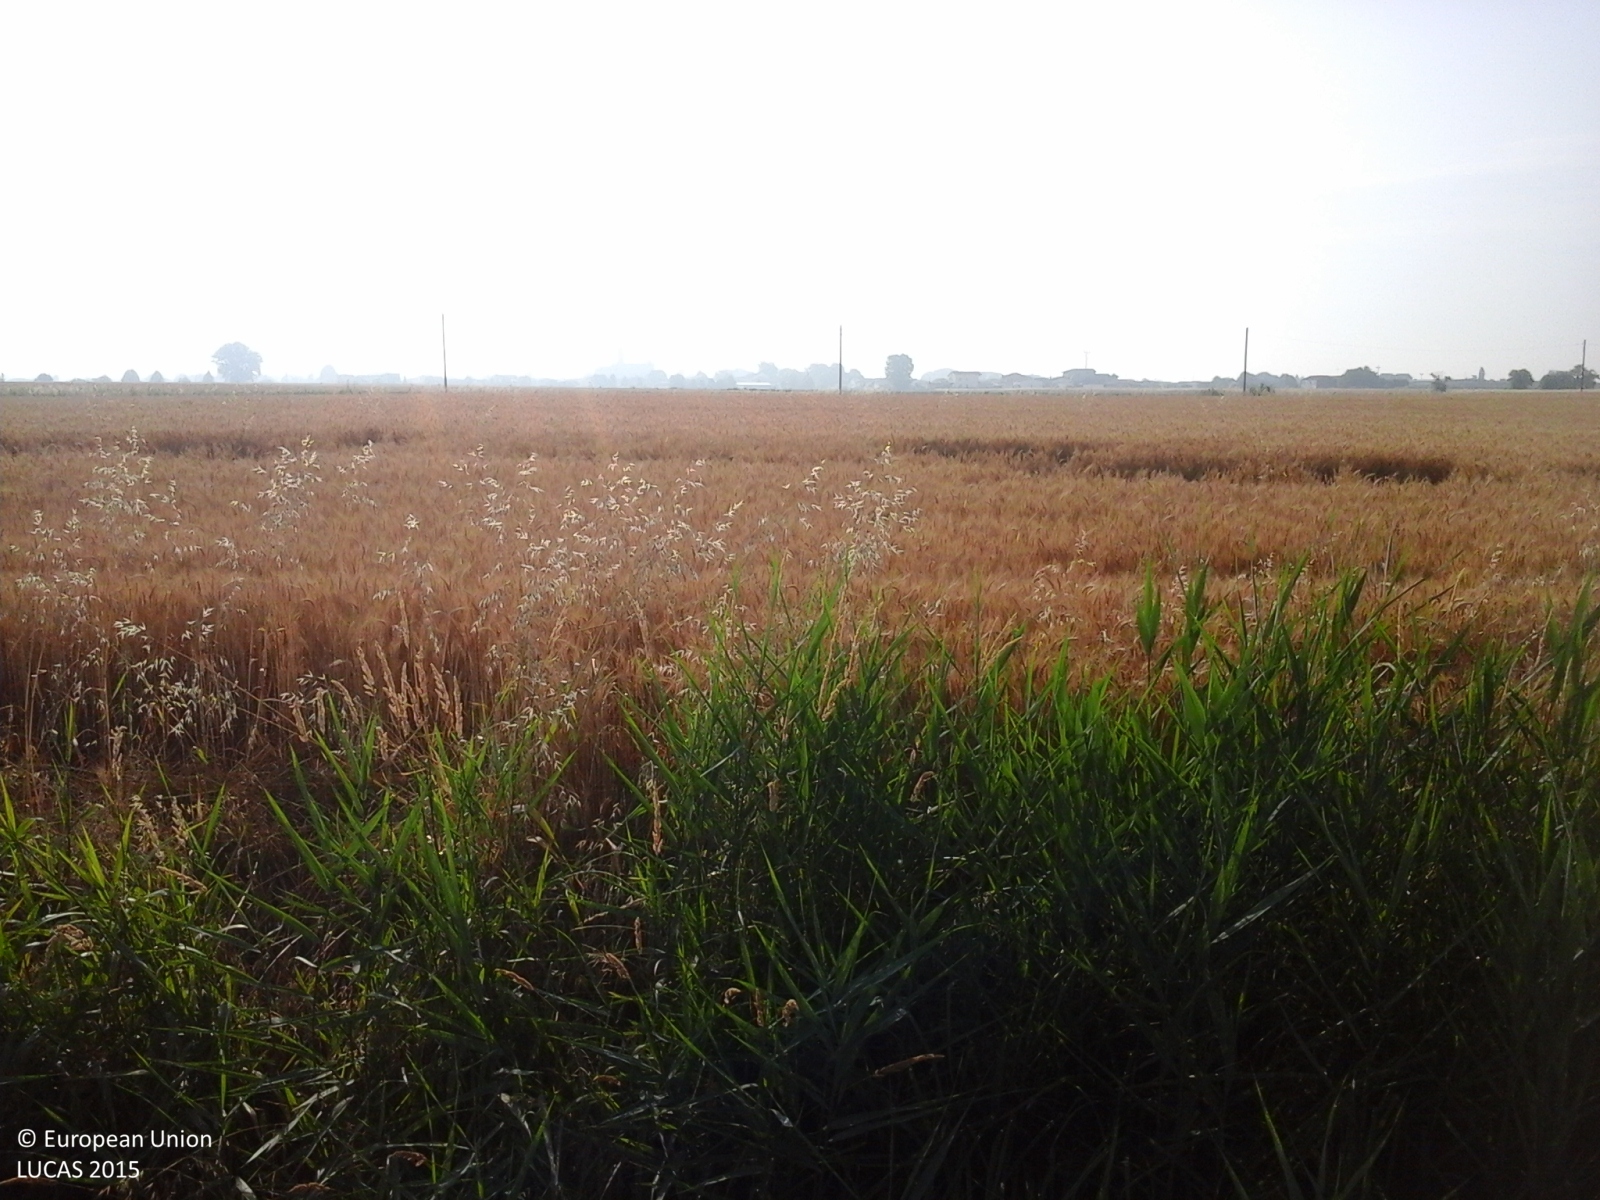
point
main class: Cropland
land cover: Common wheat
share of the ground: > 75 %
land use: Agriculture (excluding fallow land and kitchen gardens)
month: June
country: IT
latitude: 45.1733
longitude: 11.1812
